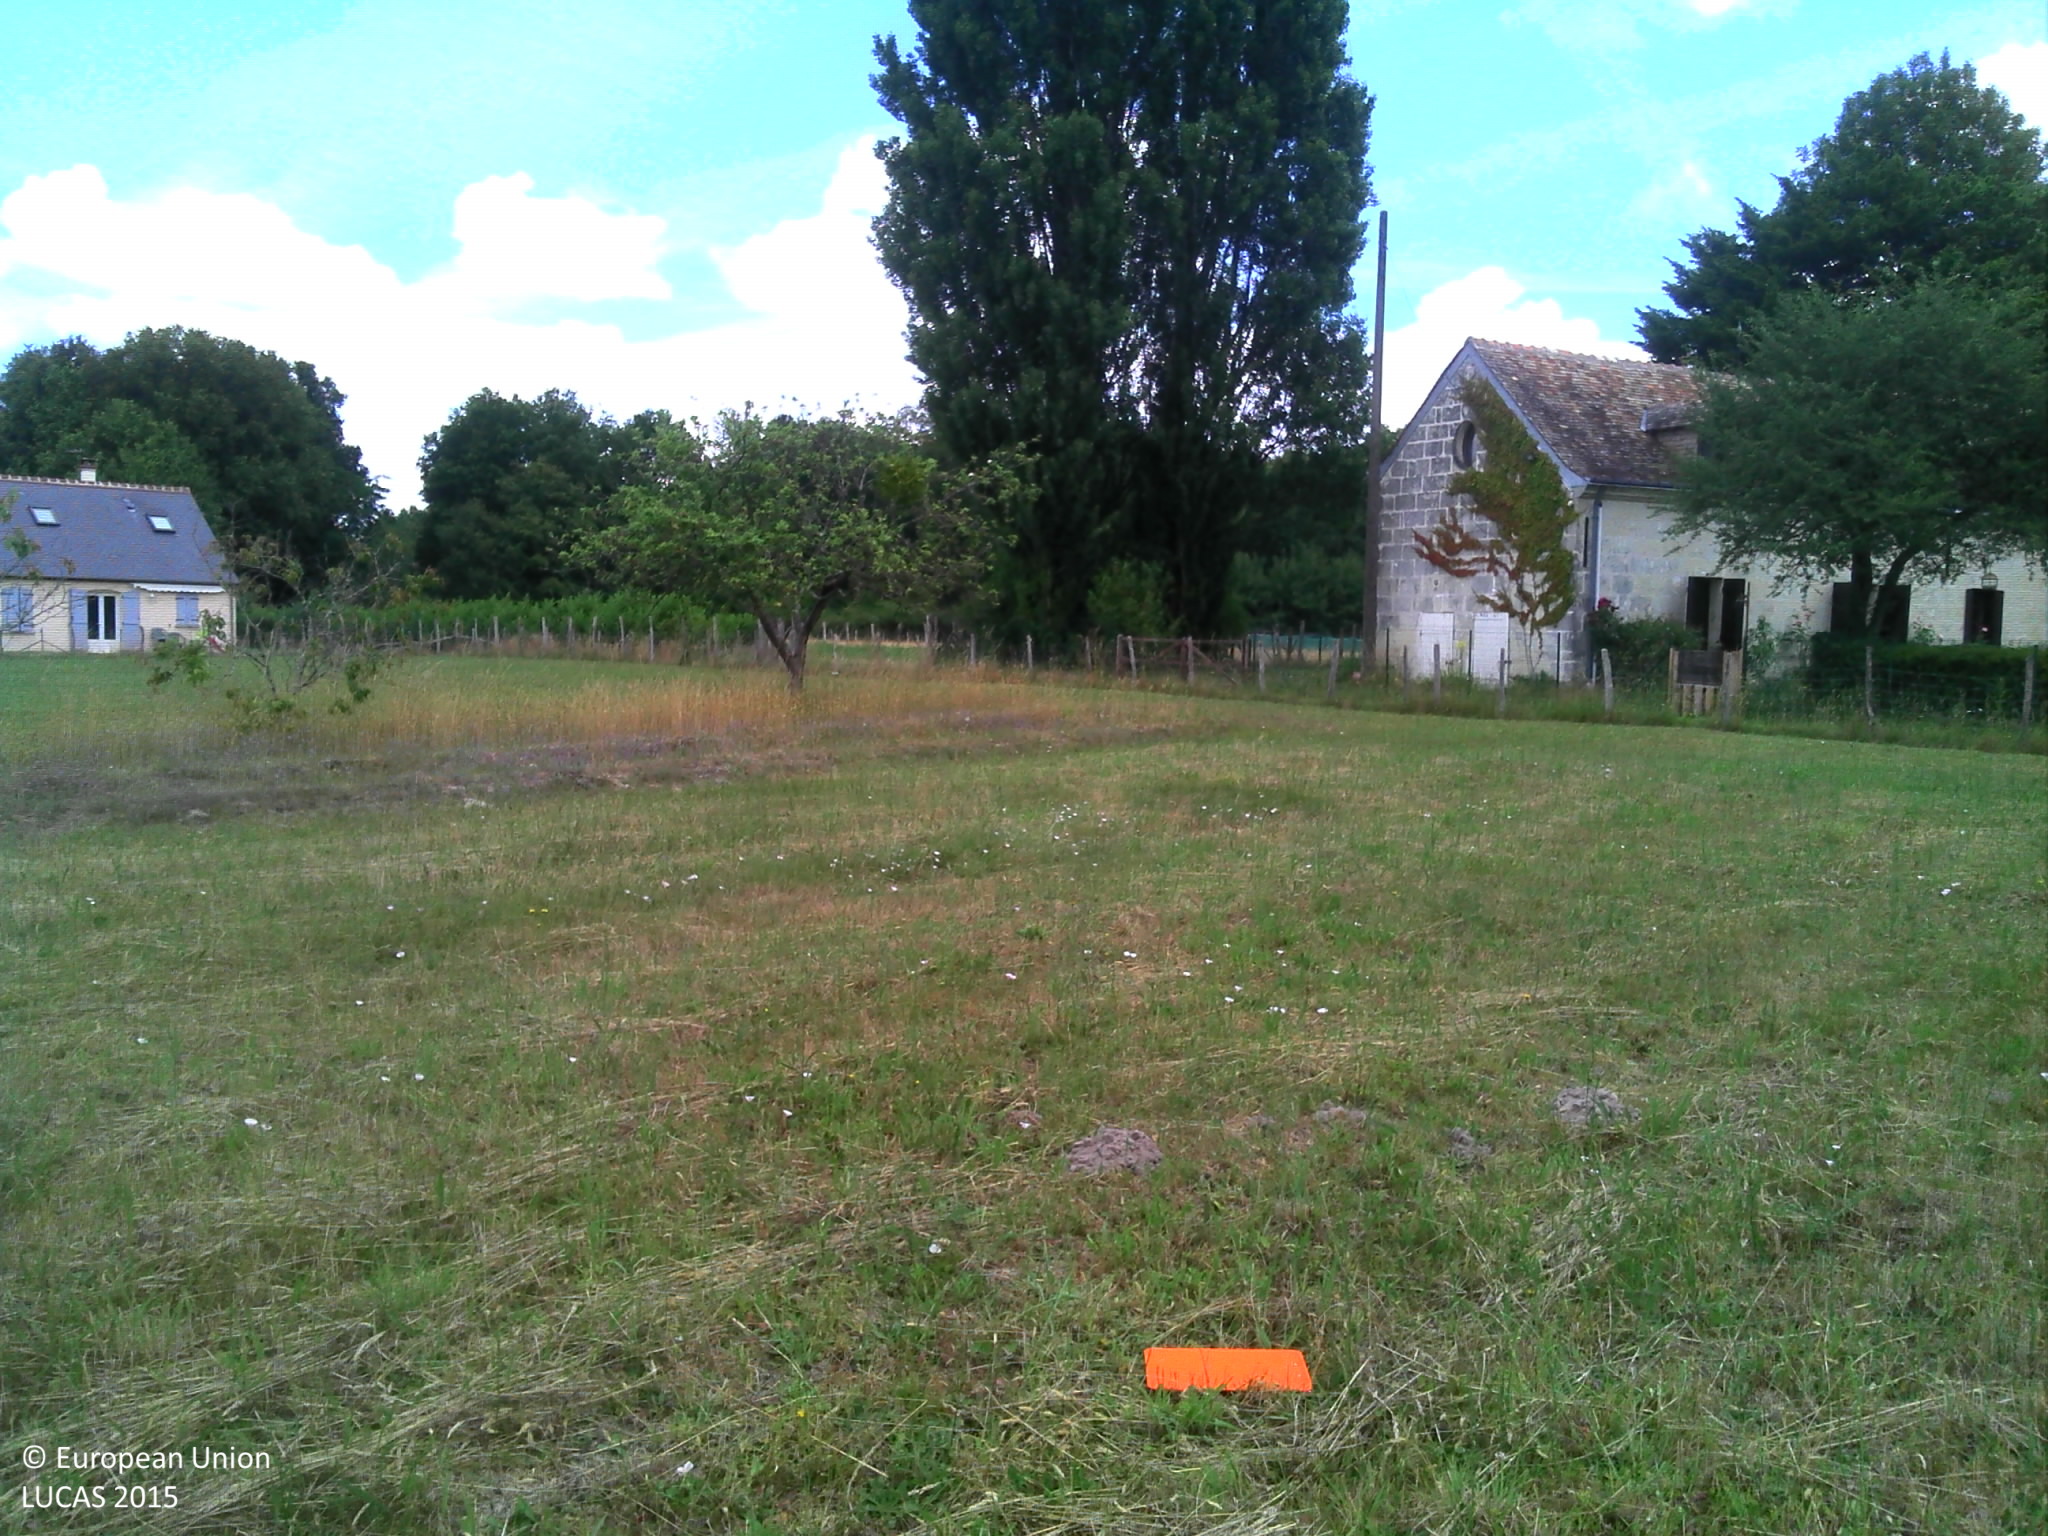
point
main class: Grassland
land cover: Grassland without tree/shrub cover
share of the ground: > 75 %
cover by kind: herbaceous plants 100 %
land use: Agriculture (excluding fallow land and kitchen gardens)
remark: Harvested field
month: June
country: FR
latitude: 47.4226
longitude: 0.3940
